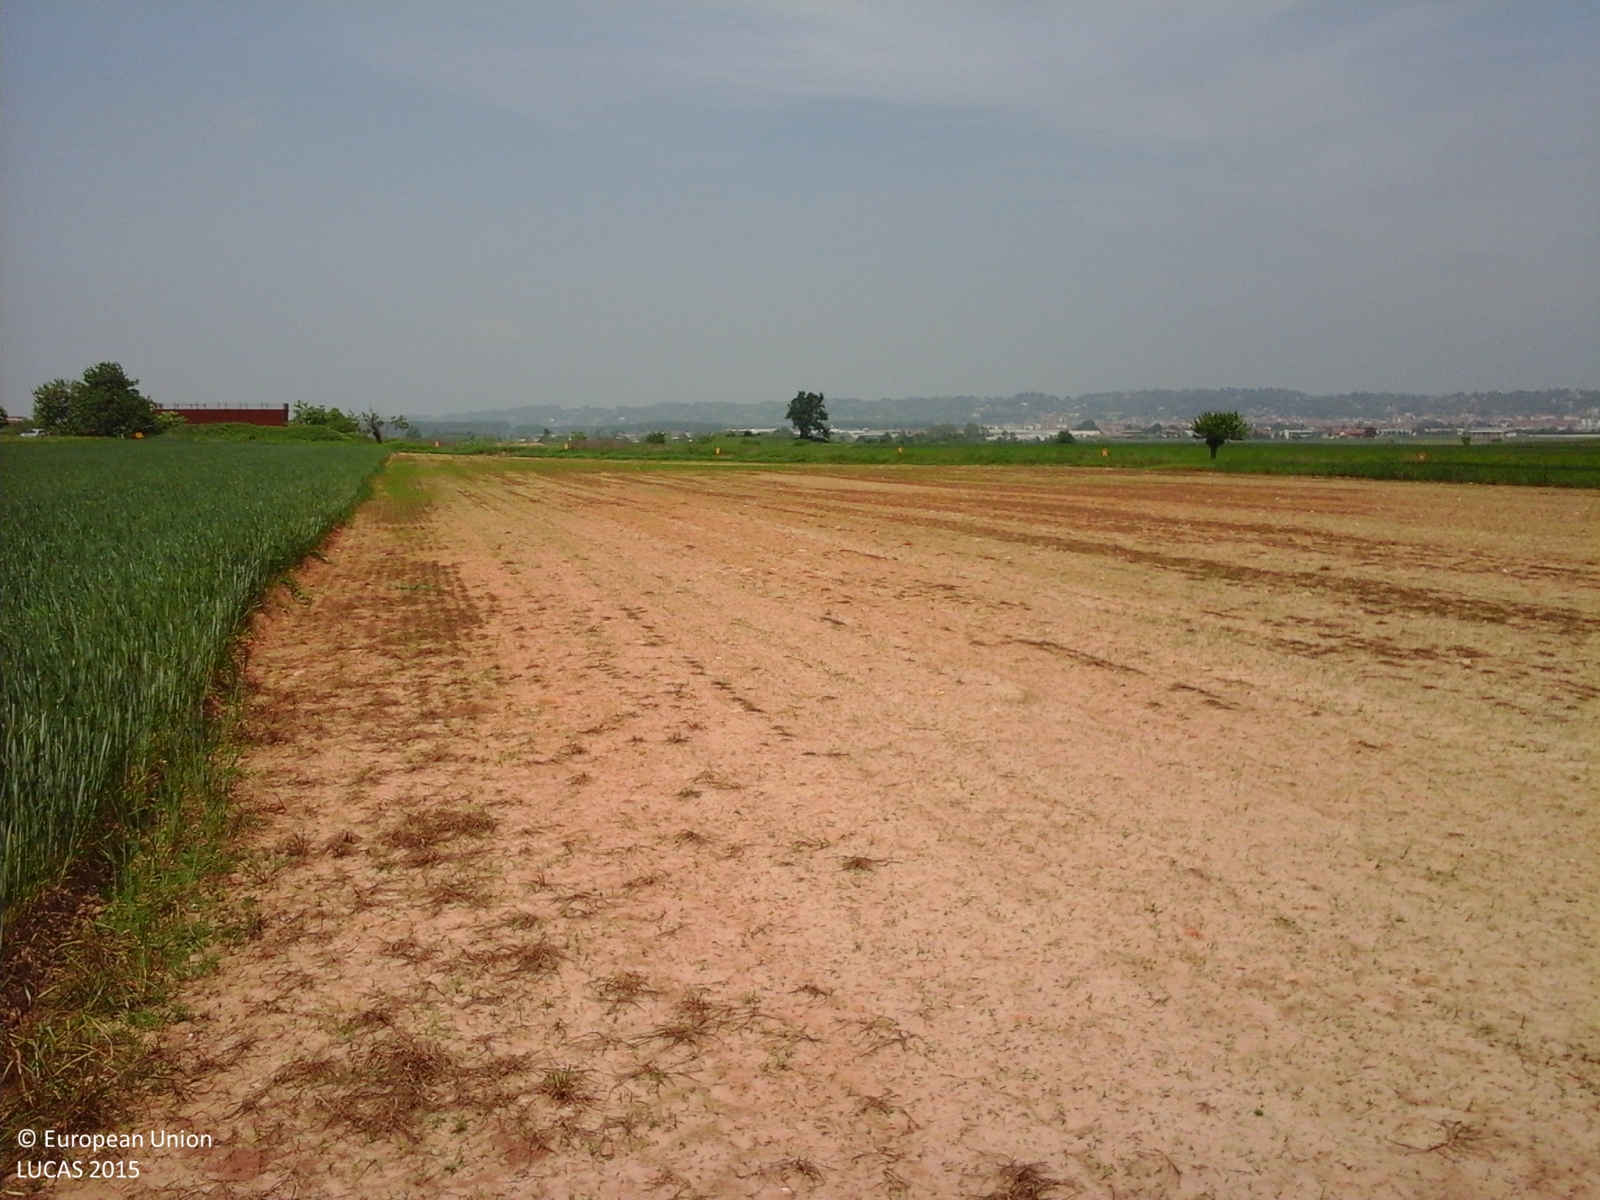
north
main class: Cropland
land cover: Common wheat
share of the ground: > 75 %
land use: Agriculture (excluding fallow land and kitchen gardens)
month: May
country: IT
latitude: 44.6705
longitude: 7.8221
